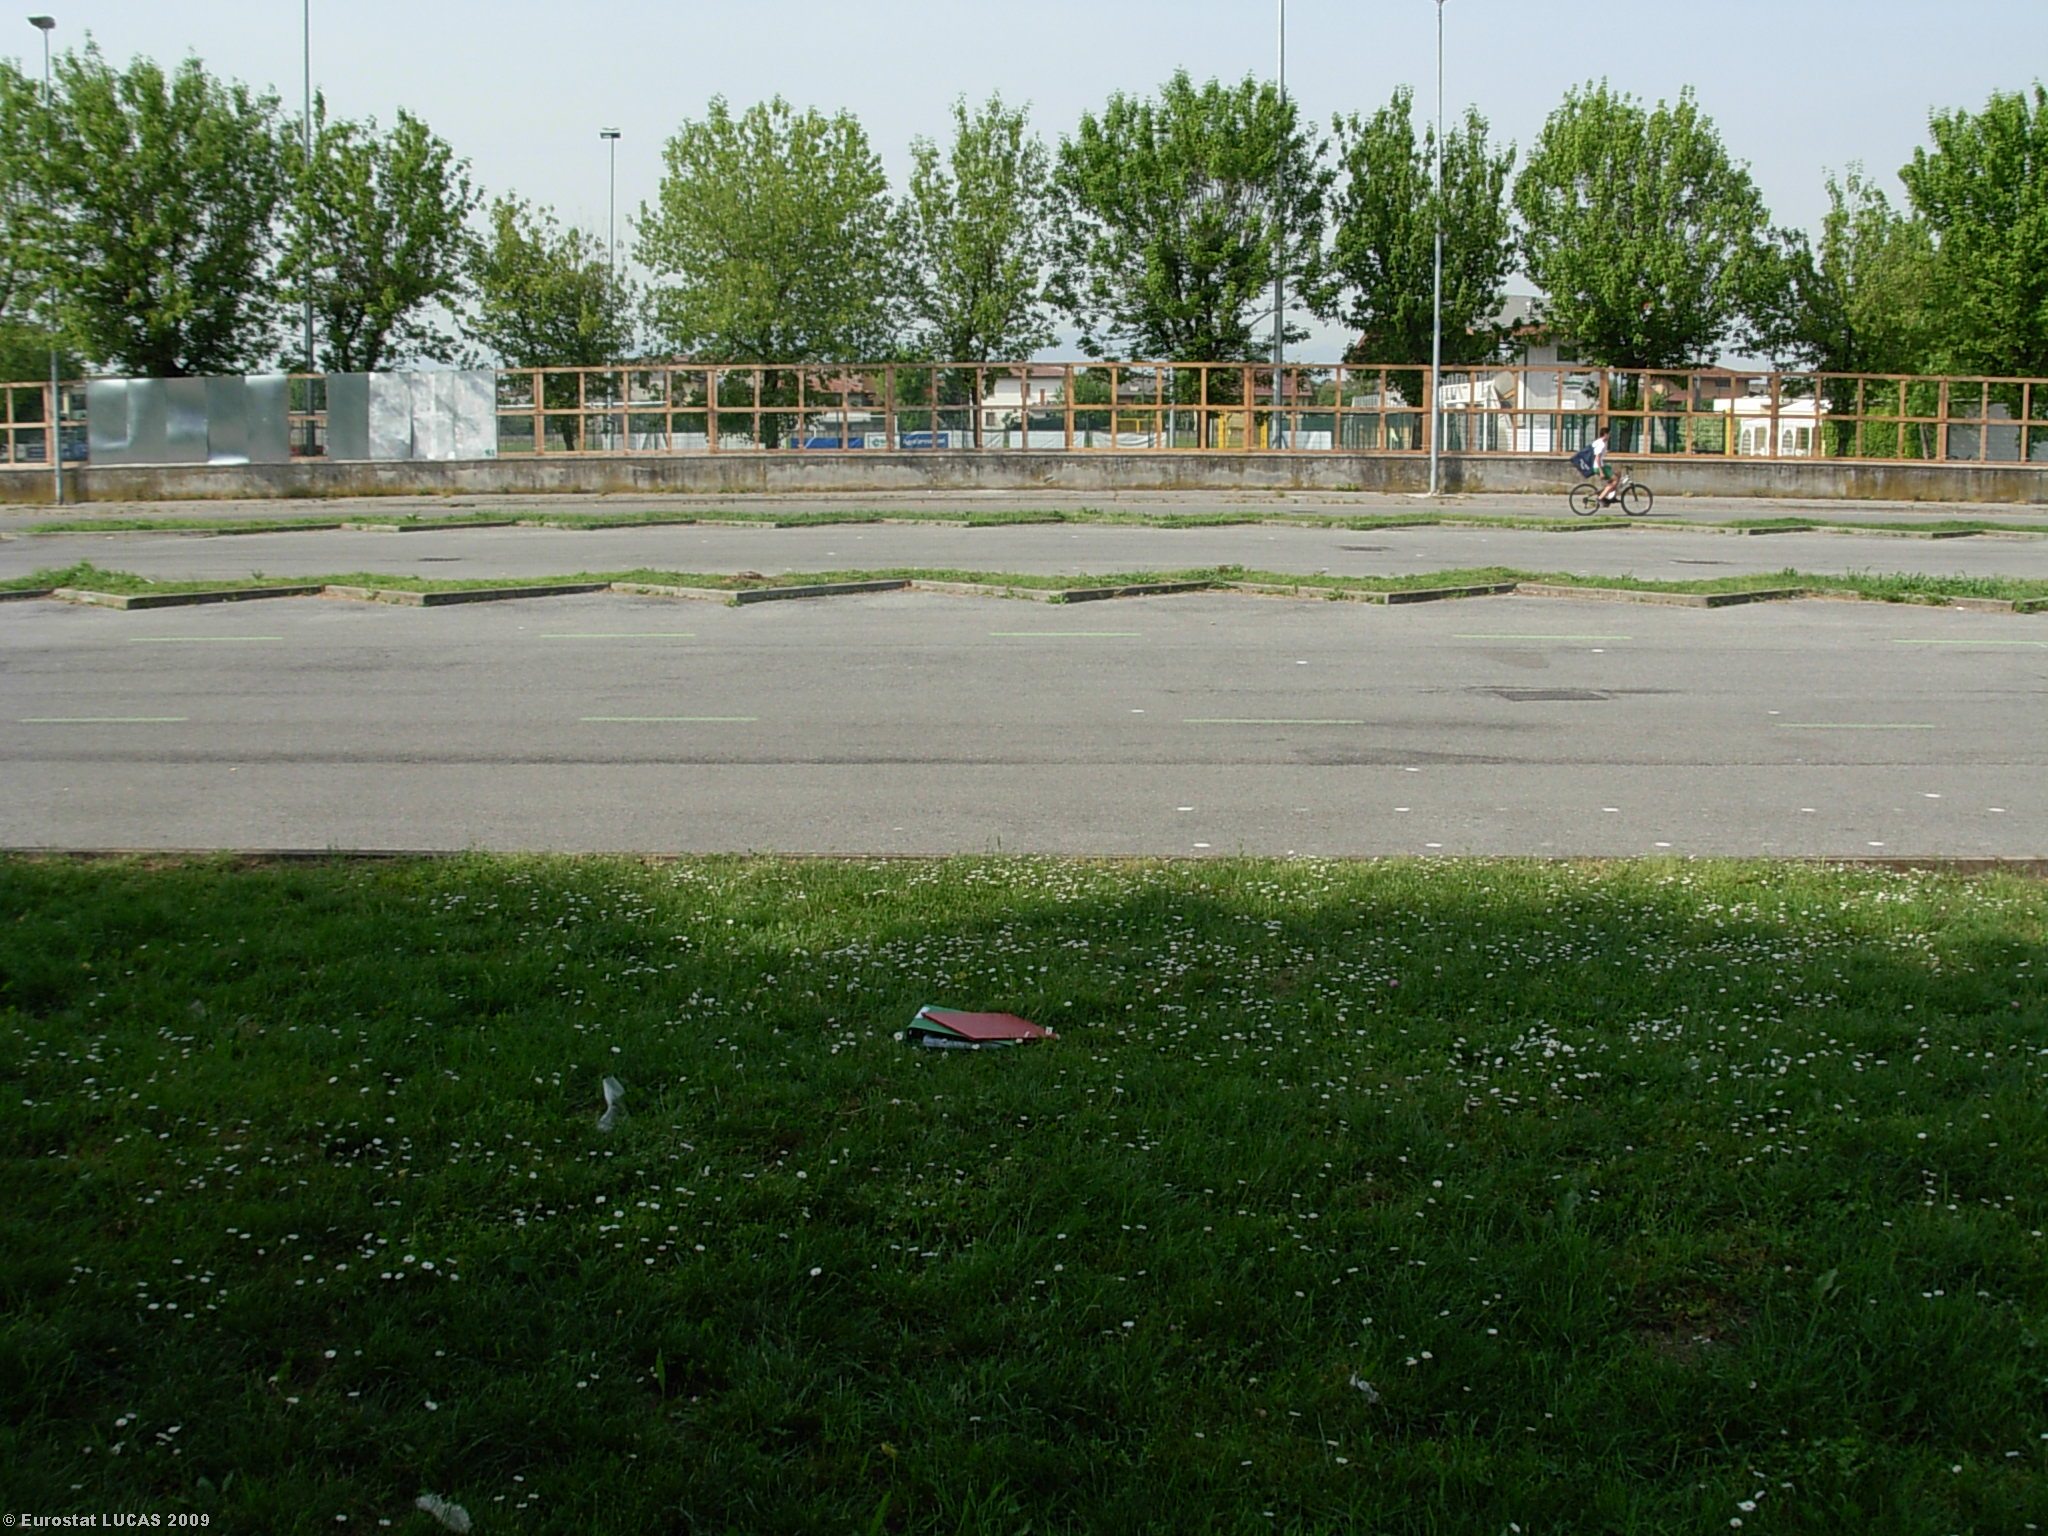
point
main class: Woodland
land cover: Broadleaved woodland
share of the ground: > 75 %
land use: Community services
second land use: Amenities, museums, leisure
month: May
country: IT
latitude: 45.3959
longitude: 10.2678
